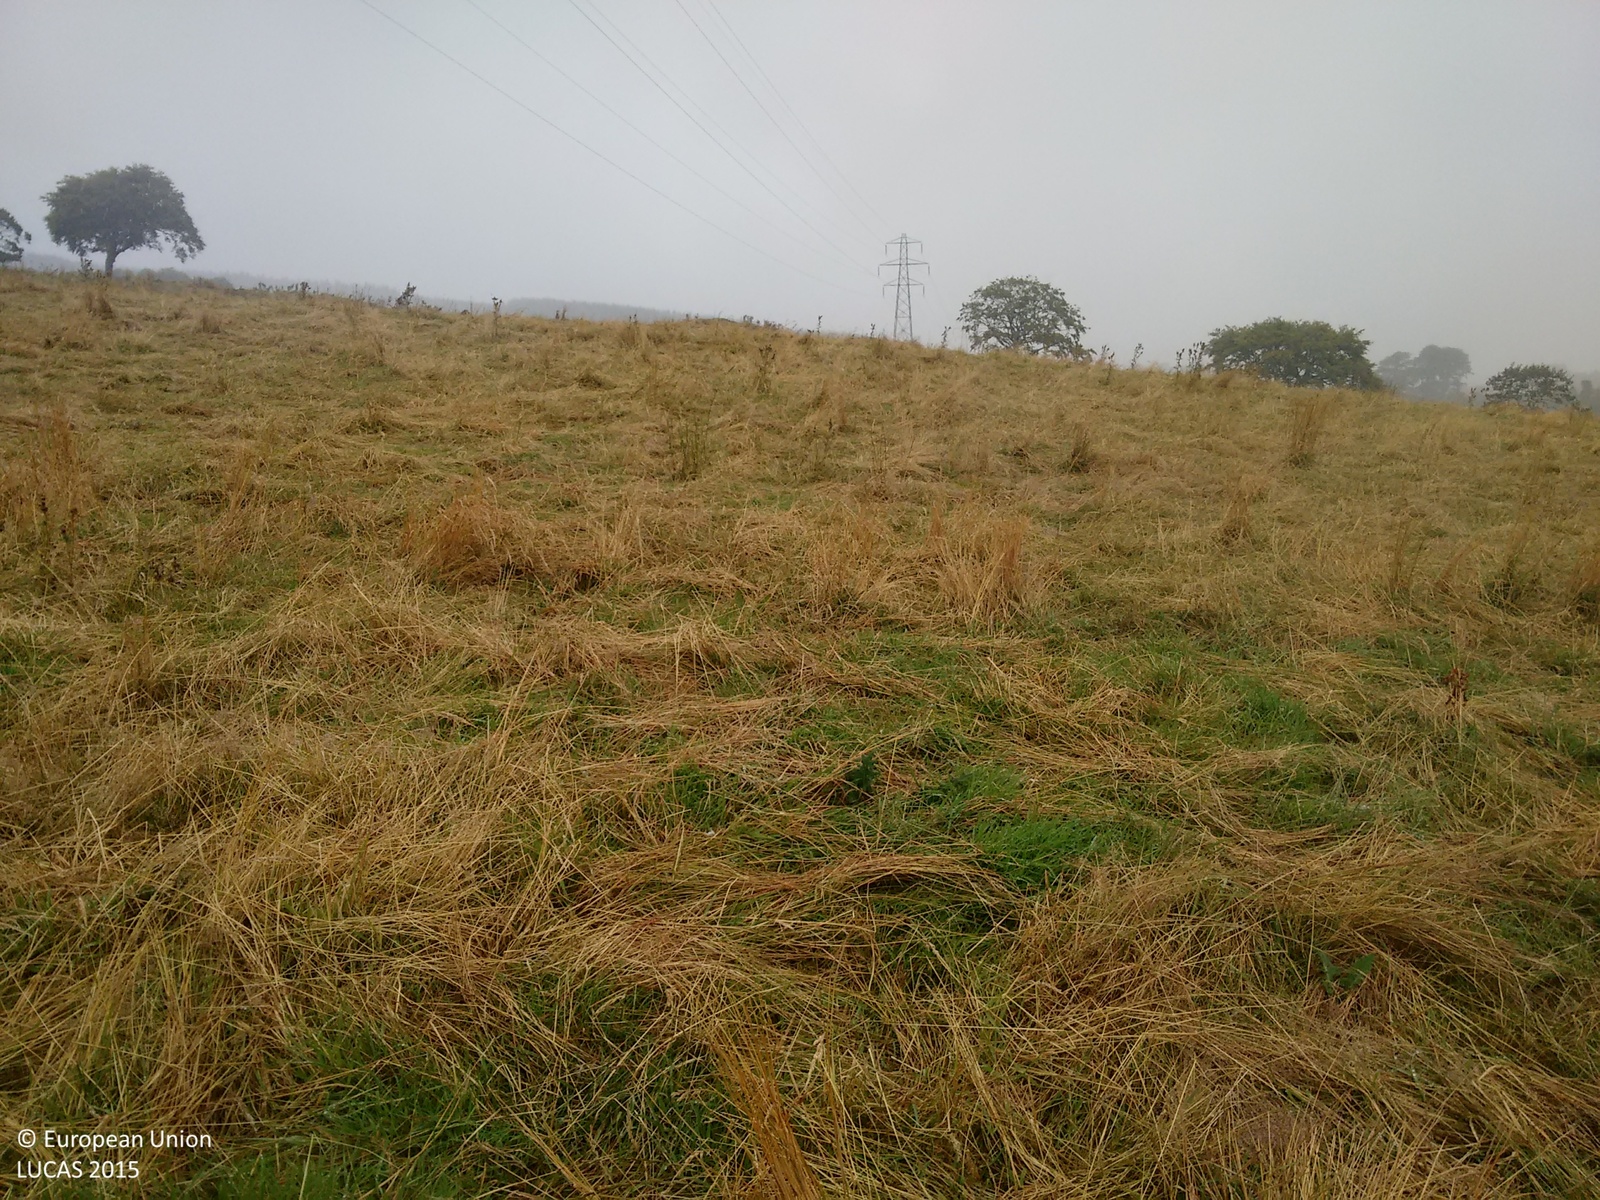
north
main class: Grassland
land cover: Grassland without tree/shrub cover
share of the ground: > 75 %
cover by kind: herbaceous plants 100 %
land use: Agriculture (excluding fallow land and kitchen gardens)
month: September
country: GB
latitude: 57.5985
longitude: -2.8584
